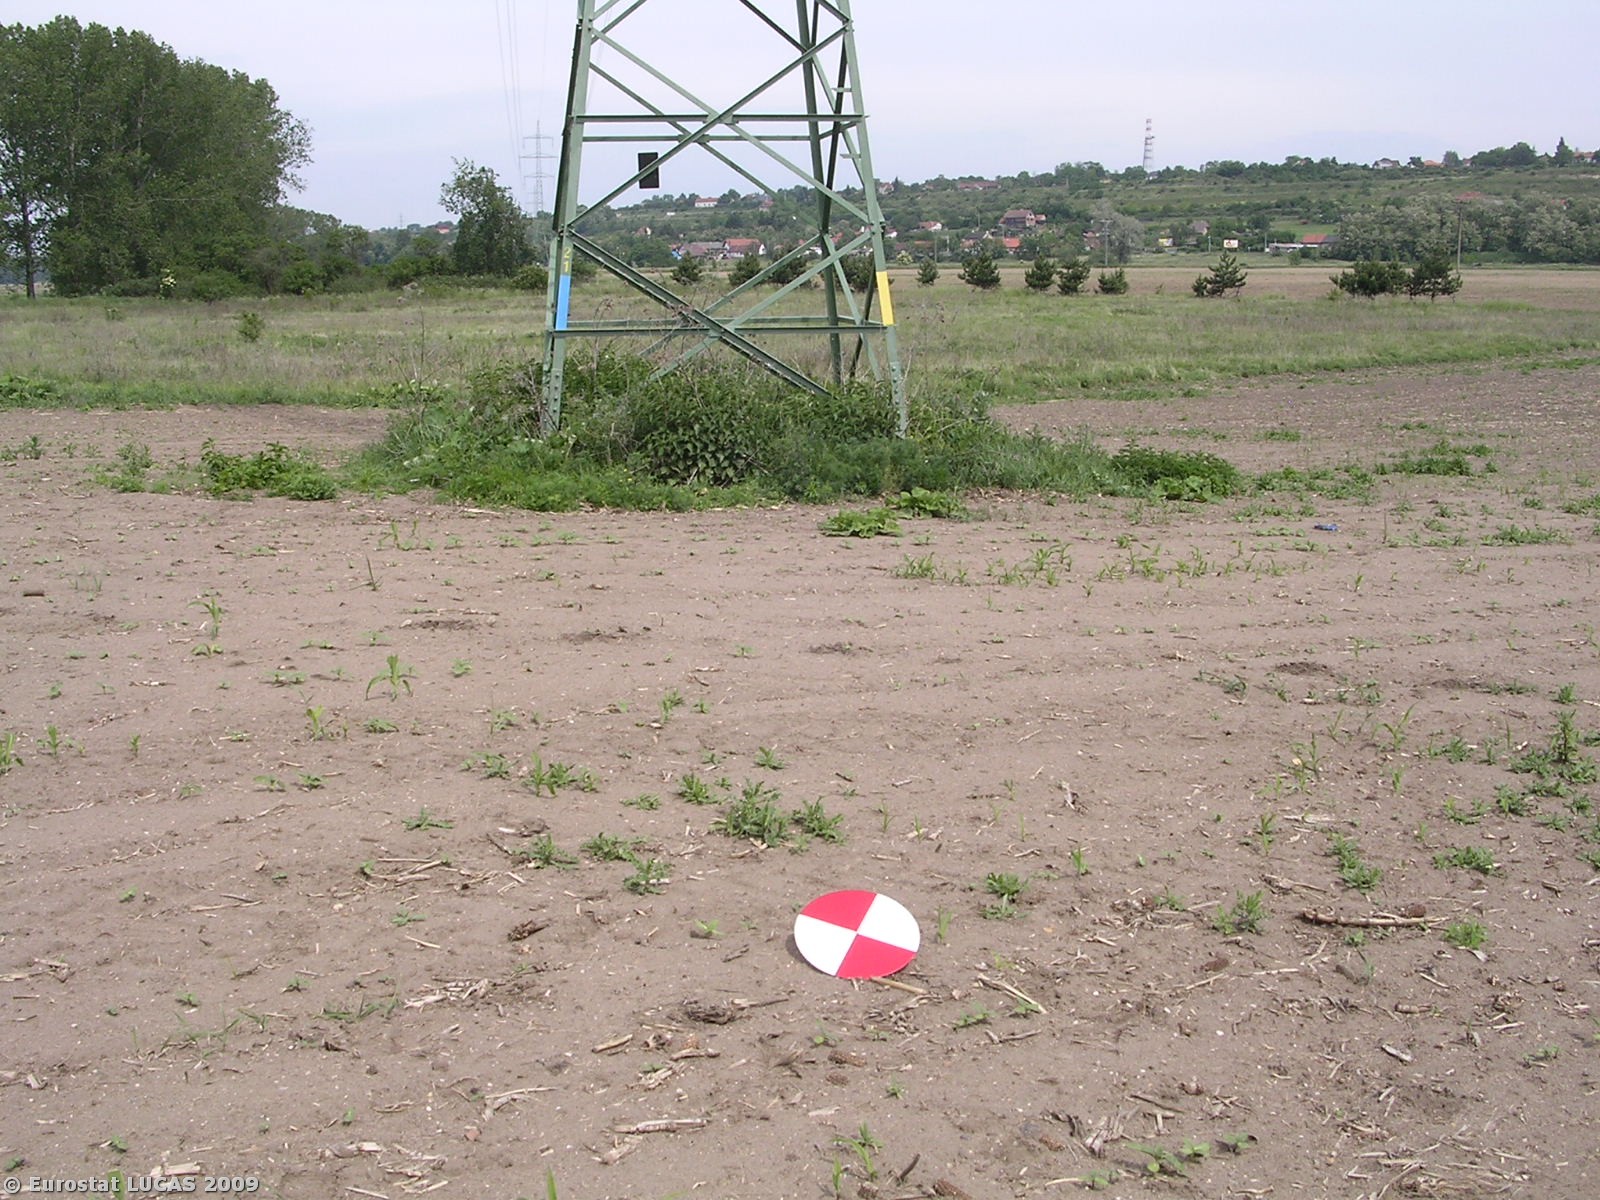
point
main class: Cropland
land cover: Sunflower
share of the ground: < 10 %
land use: Agriculture (excluding fallow land and kitchen gardens)
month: May
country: CZ
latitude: 50.3112
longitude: 14.5093
